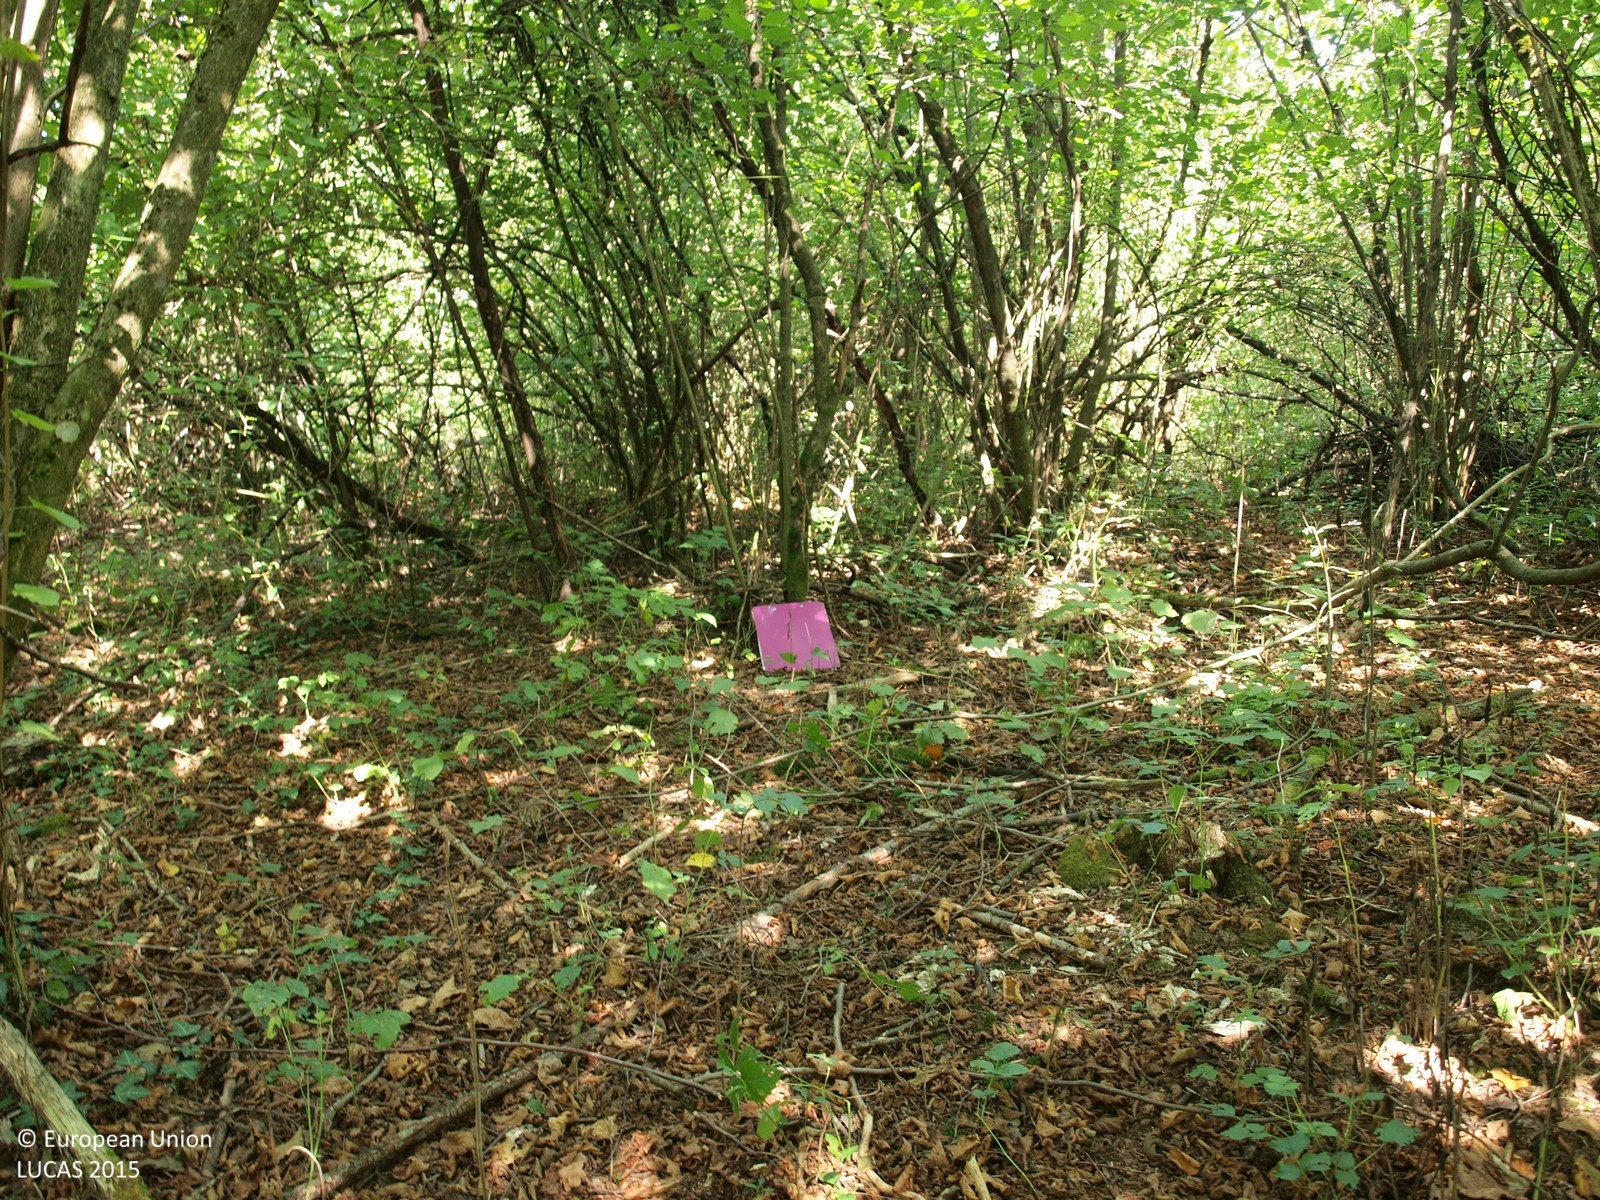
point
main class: Woodland
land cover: Broadleaved woodland
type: mesophytic deciduous forest
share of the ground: > 75 %
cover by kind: broadleaved forest trees 100 %
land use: Forestry
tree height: > 5 m
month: August
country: HR
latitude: 45.6636
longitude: 16.5317
